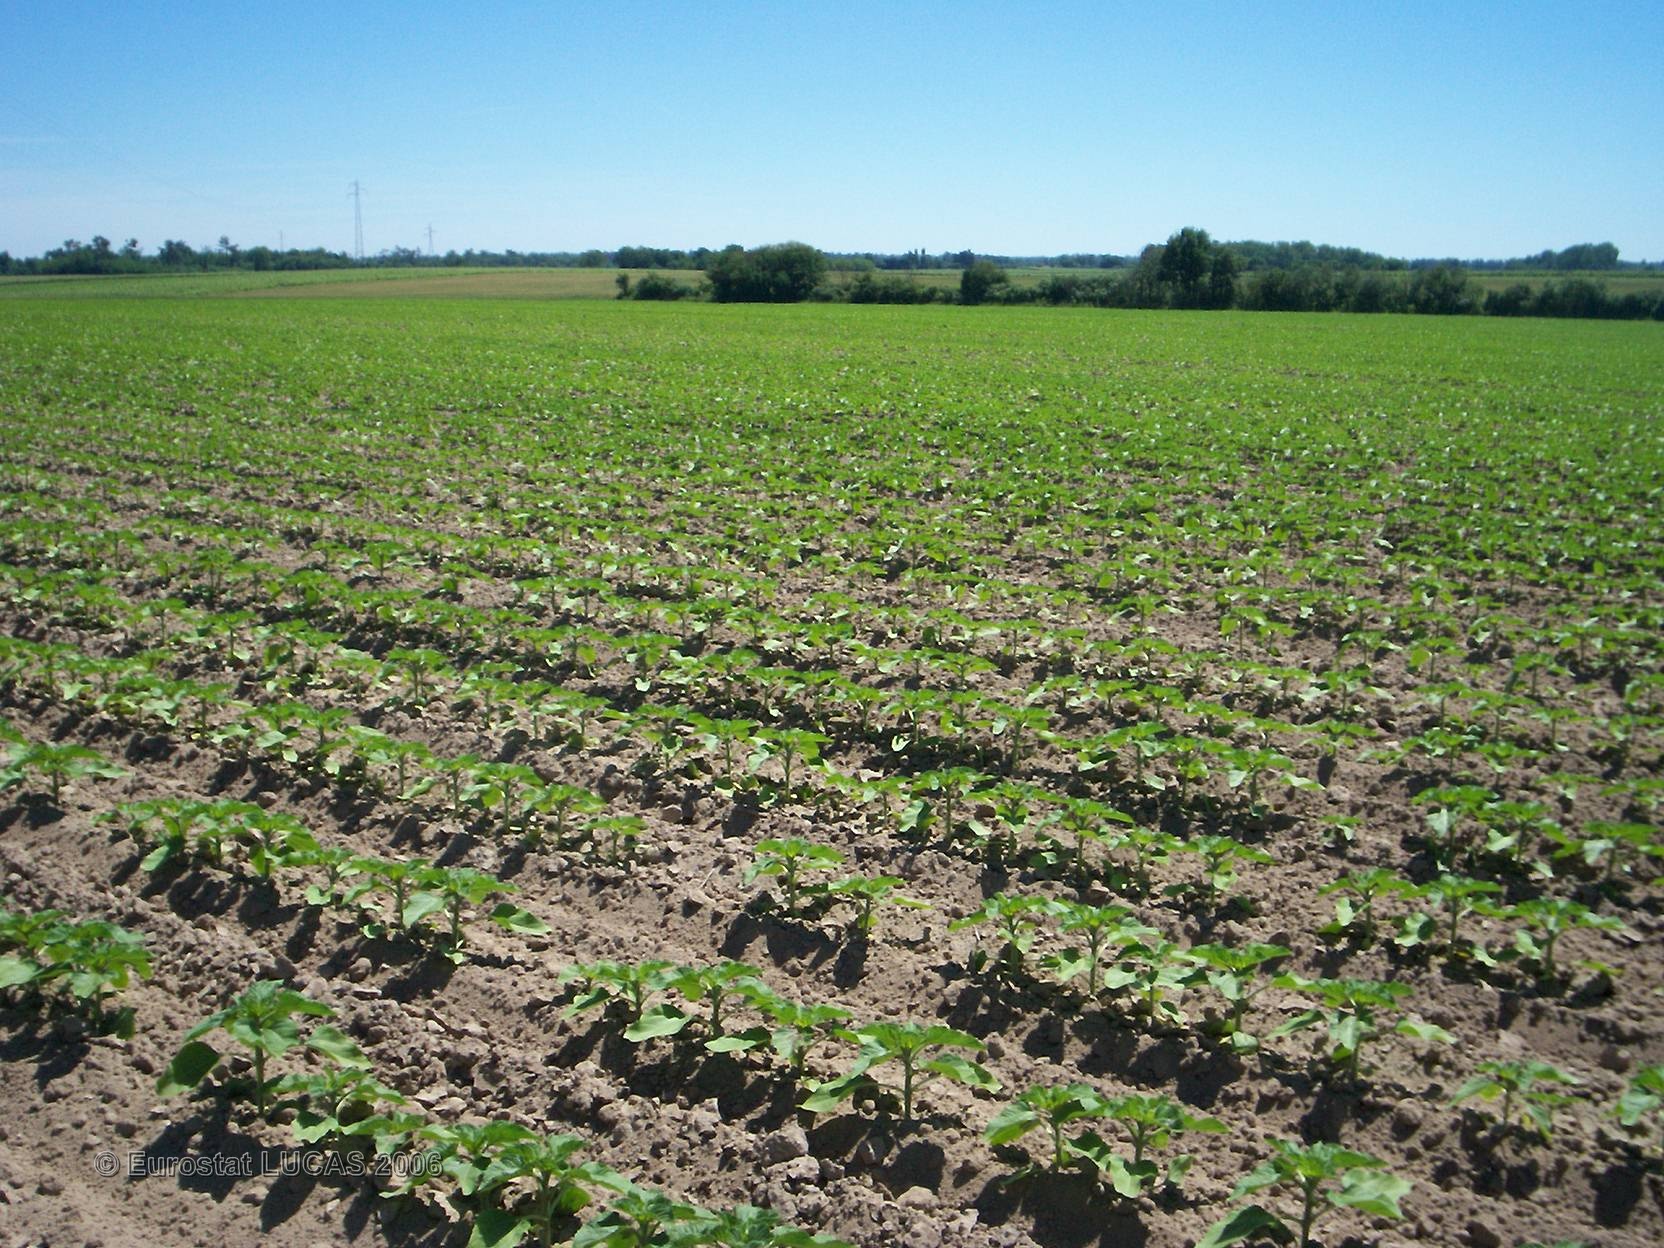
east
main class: Cropland
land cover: Sunflower
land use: Agriculture (excluding fallow land and kitchen gardens)
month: May
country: FR
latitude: 45.5005
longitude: -0.7356
